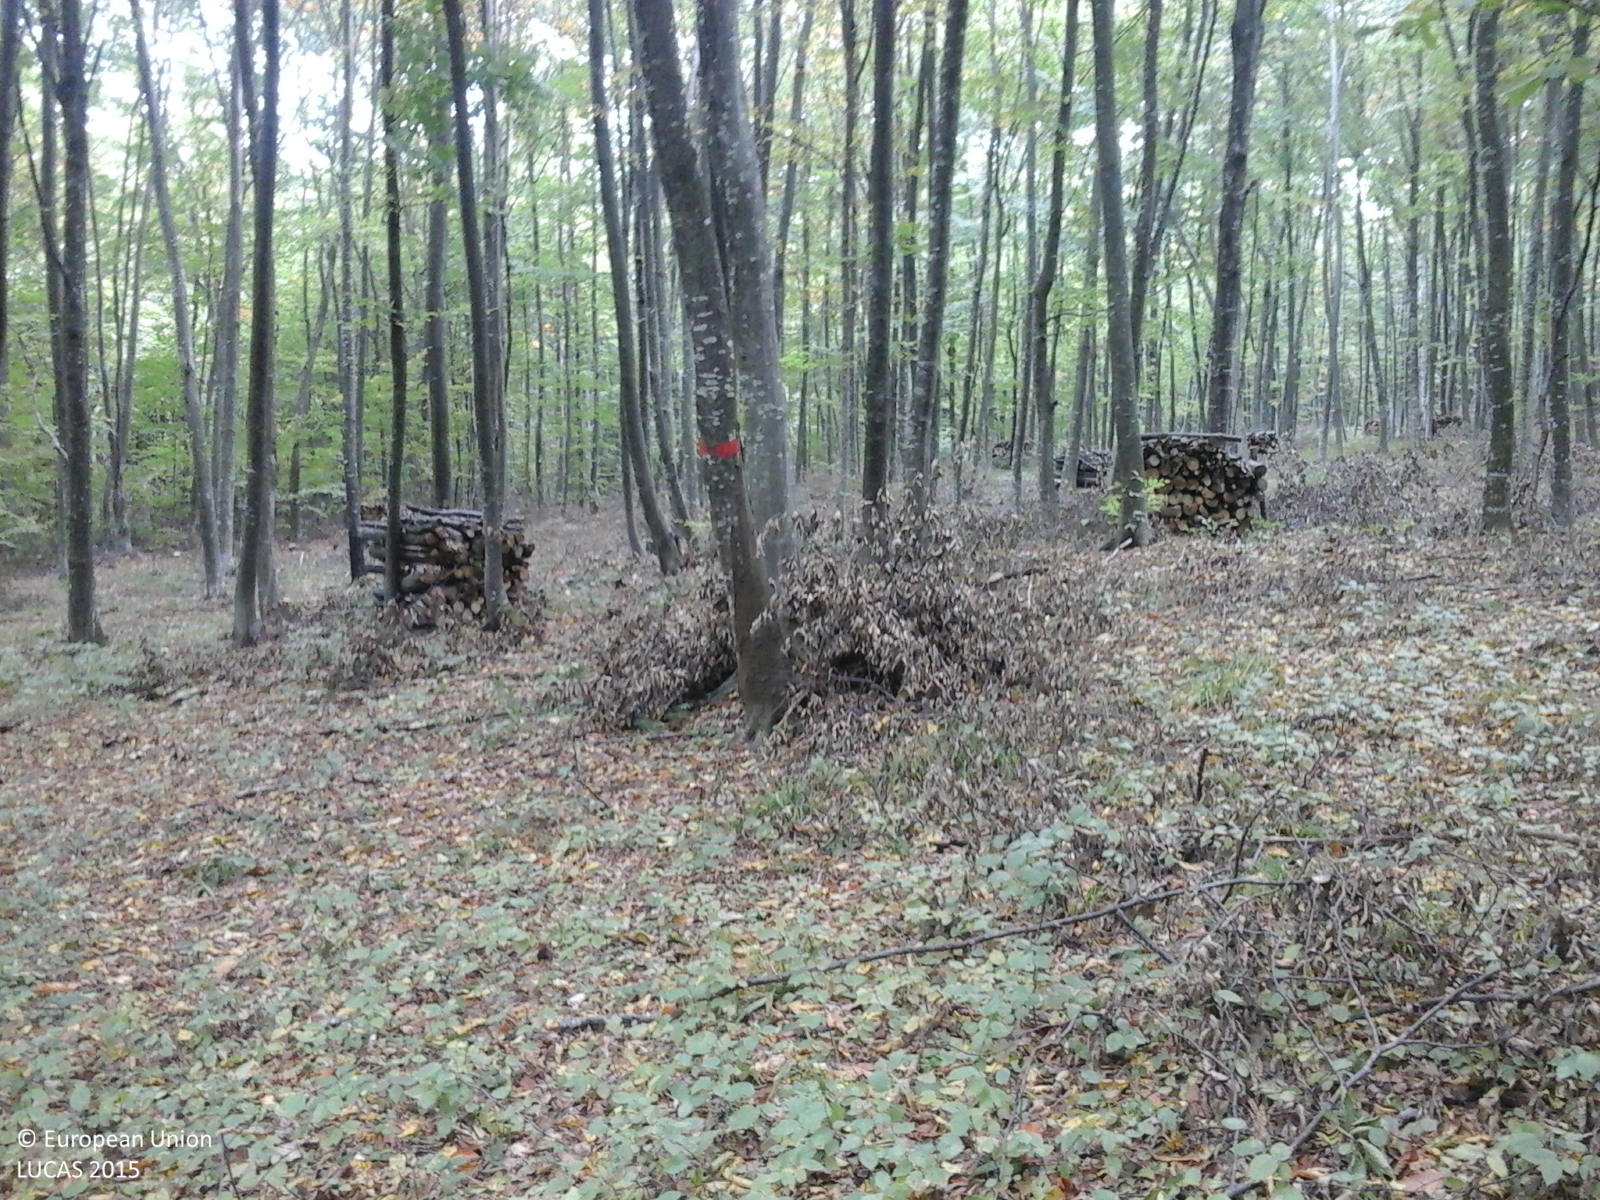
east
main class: Woodland
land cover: Broadleaved woodland
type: beech forest
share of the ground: > 75 %
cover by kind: broadleaved forest trees 100 %
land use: Forestry
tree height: > 5 m
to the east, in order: Broadleaved woodland
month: October
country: RO
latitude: 46.4599
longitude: 25.1125
